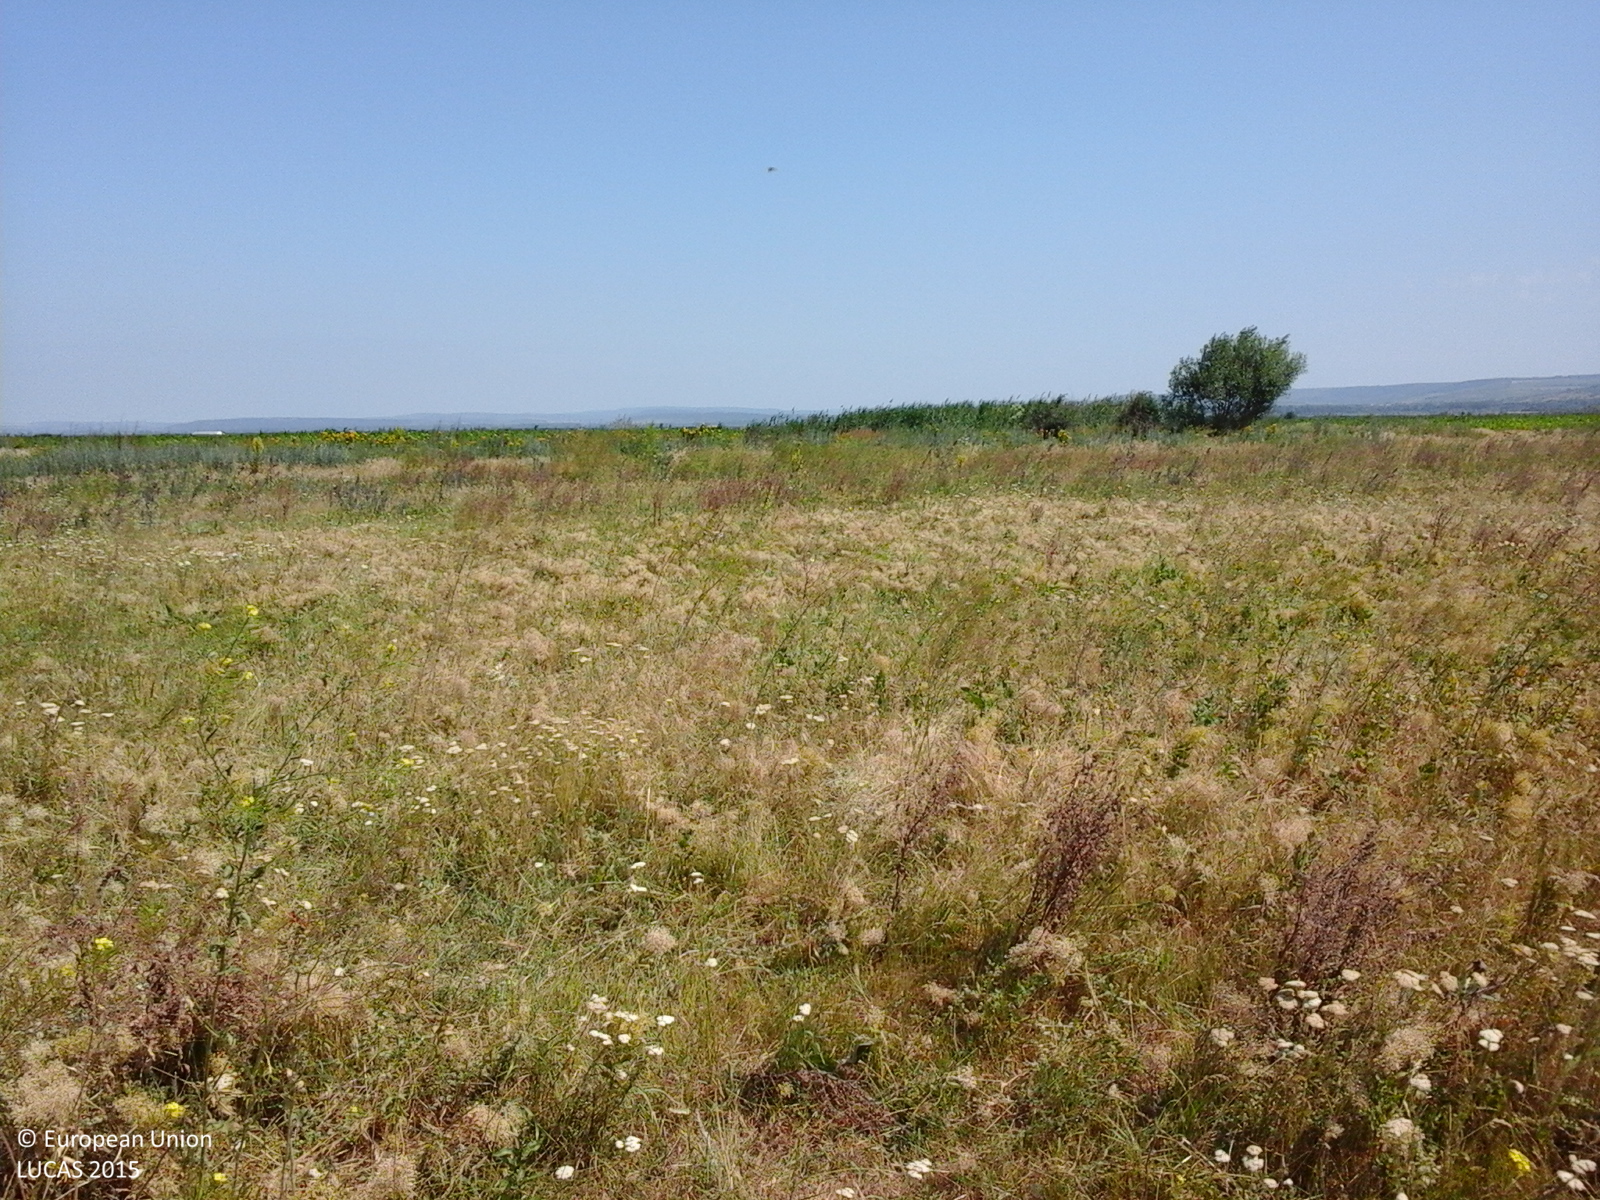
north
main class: Grassland
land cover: Grassland without tree/shrub cover
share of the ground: > 75 %
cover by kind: herbaceous plants 100 %
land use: Agriculture (excluding fallow land and kitchen gardens)
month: June
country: RO
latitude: 46.9185
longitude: 28.0558
